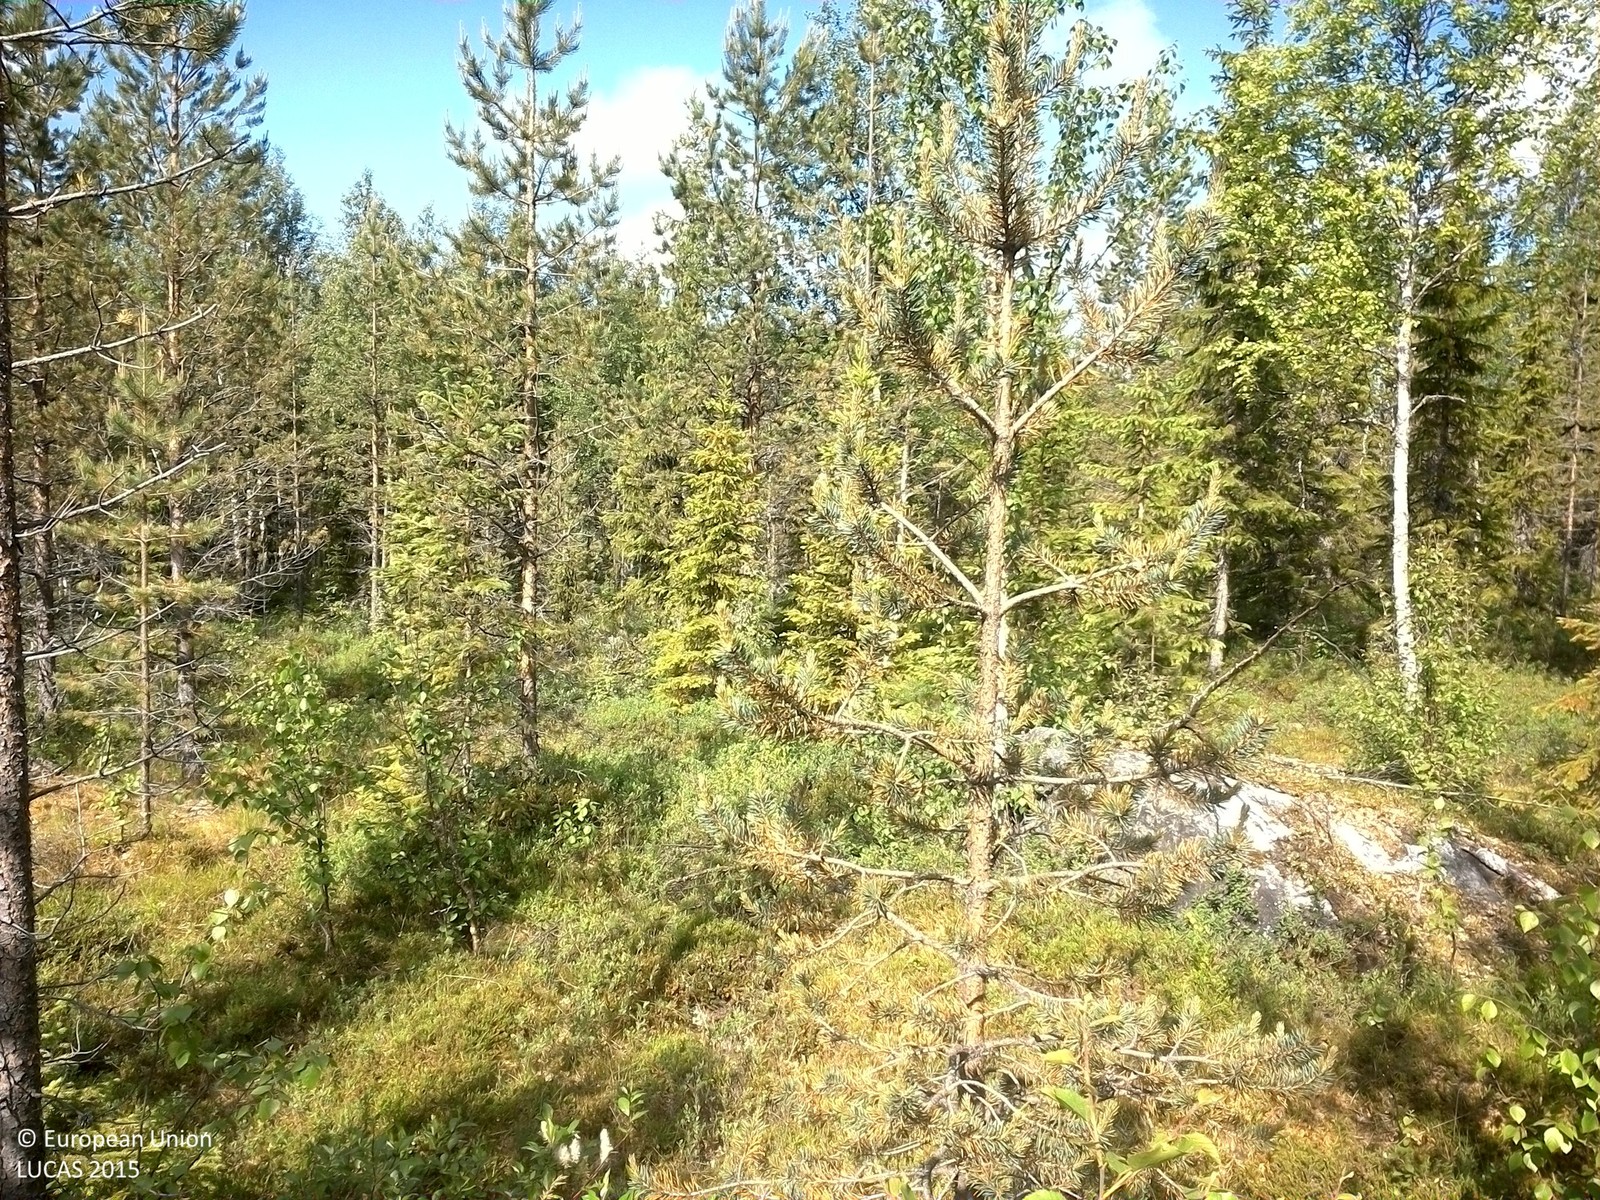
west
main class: Woodland
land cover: Pine dominated mixed woodland
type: boreal forest
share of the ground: 50 - 75 %
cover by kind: coniferous forest trees 40 %, shrubs 20 %, broadleaved forest trees 15 %, herbaceous plants 10 %, lichens and mosses 10 %, consolidated bare surface 5 %
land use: Forestry
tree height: < 5 m
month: July
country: SE
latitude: 64.3225
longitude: 16.8565
